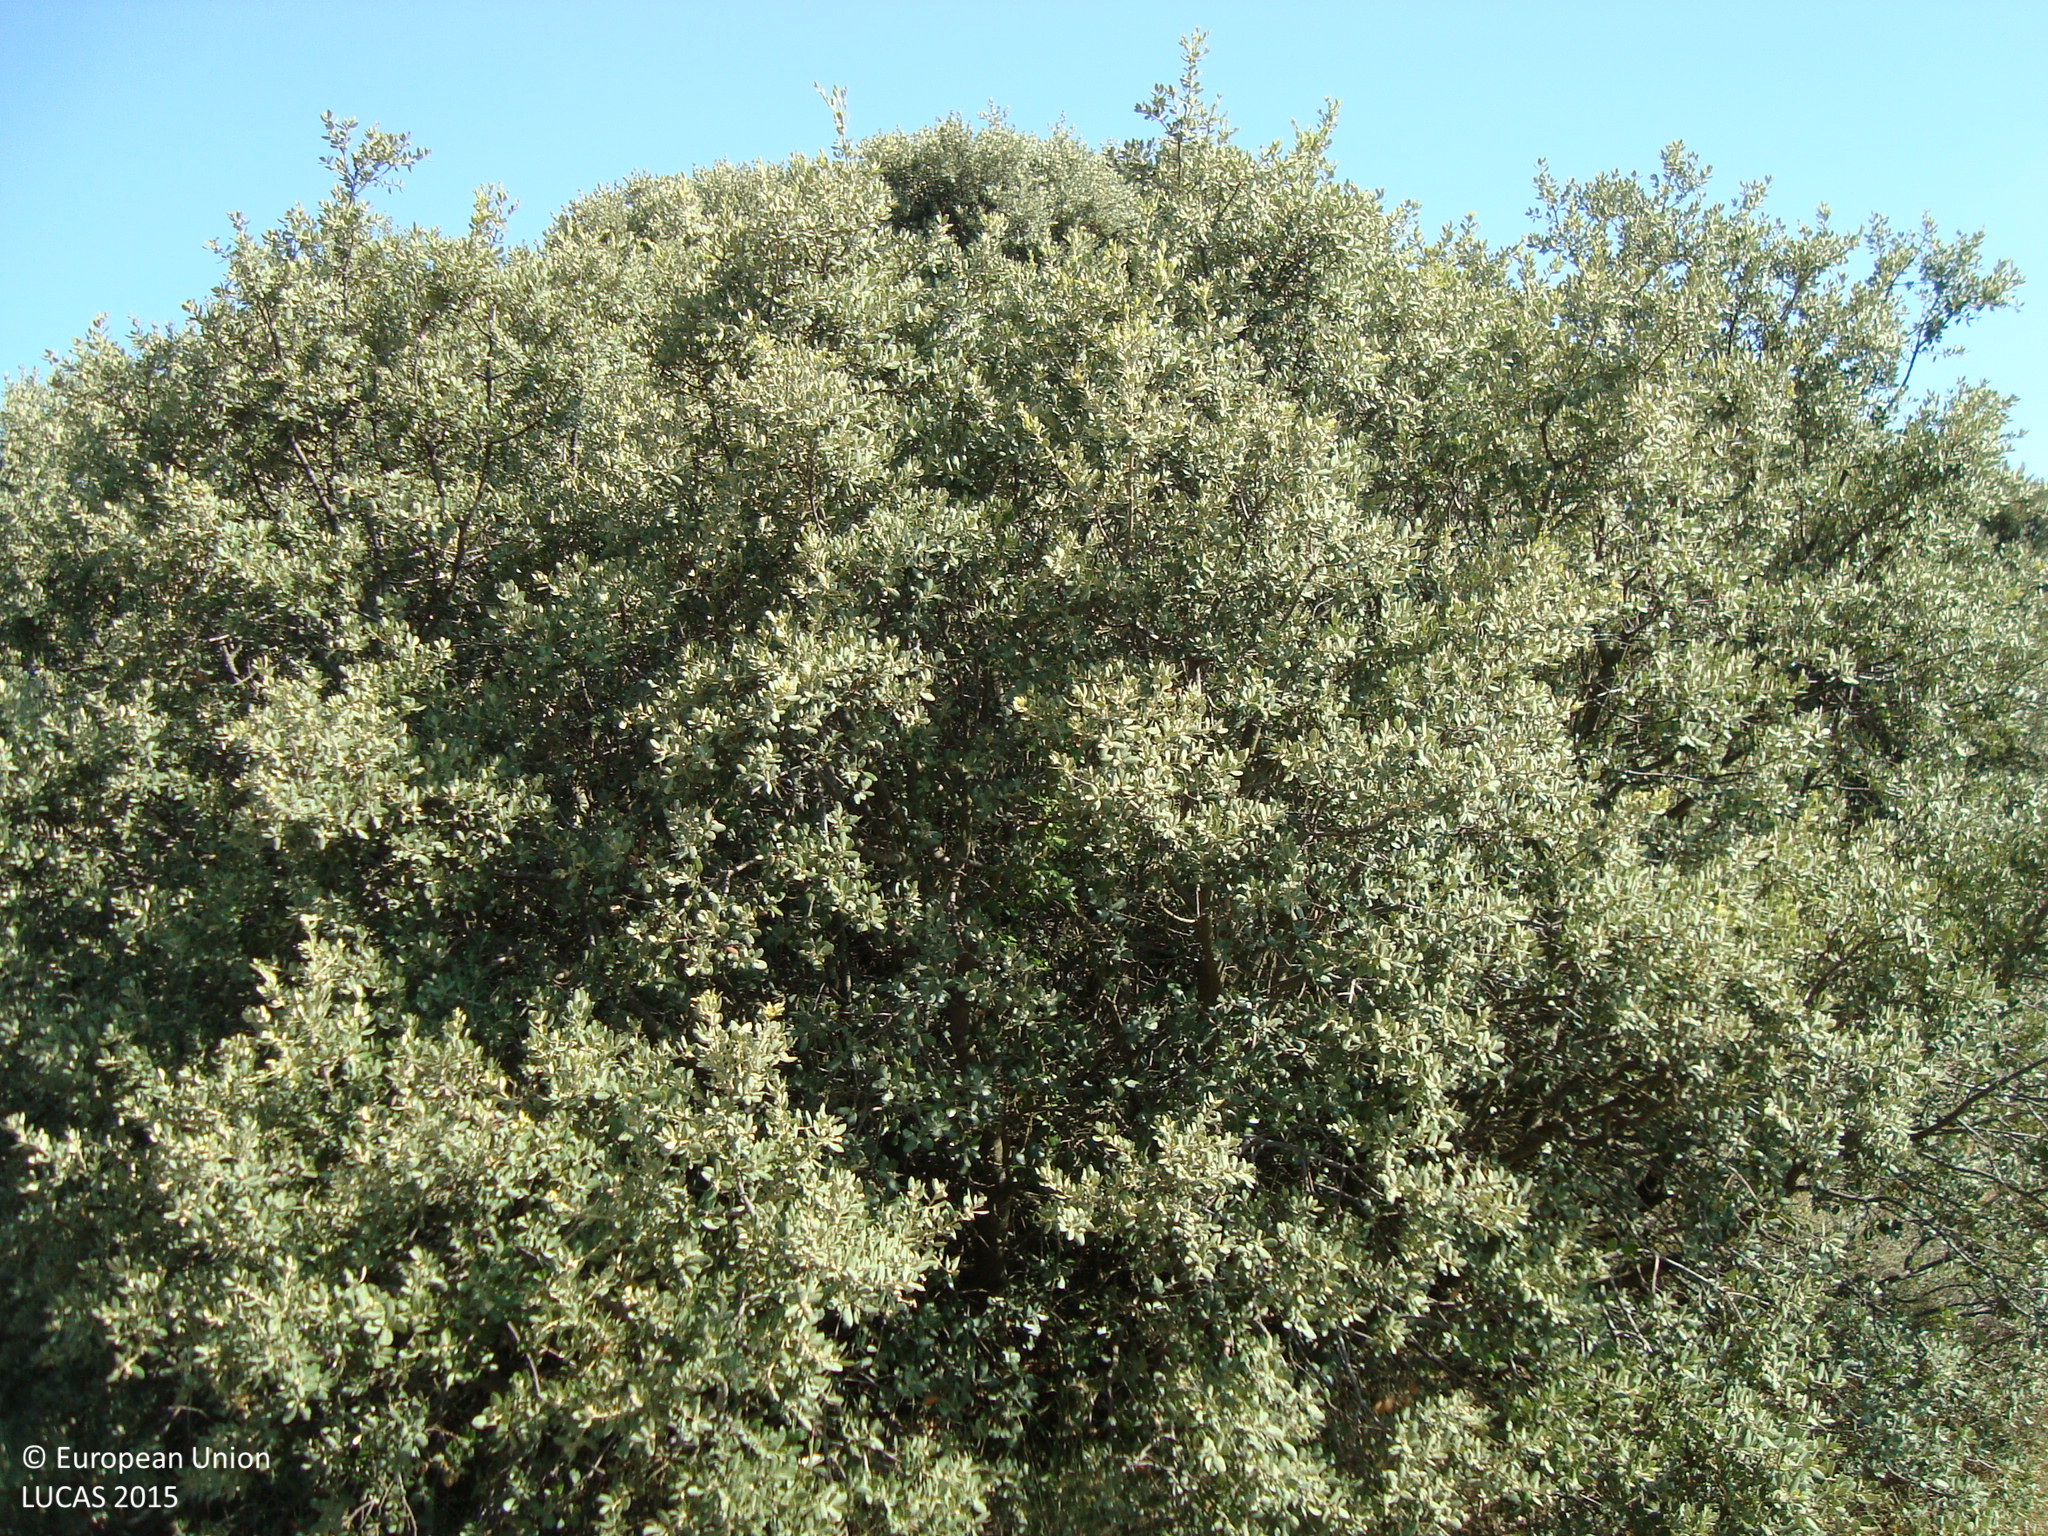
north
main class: Woodland
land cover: Broadleaved woodland
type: broadleaved evergreen forest
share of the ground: 10 - 25 %
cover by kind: unconsolidated bare surface 40 %, herbaceous plants 30 %, broadleaved forest trees 15 %, shrubs 10 %
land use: Forestry
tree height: > 5 m
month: July
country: ES
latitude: 41.7940
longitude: -4.2021
